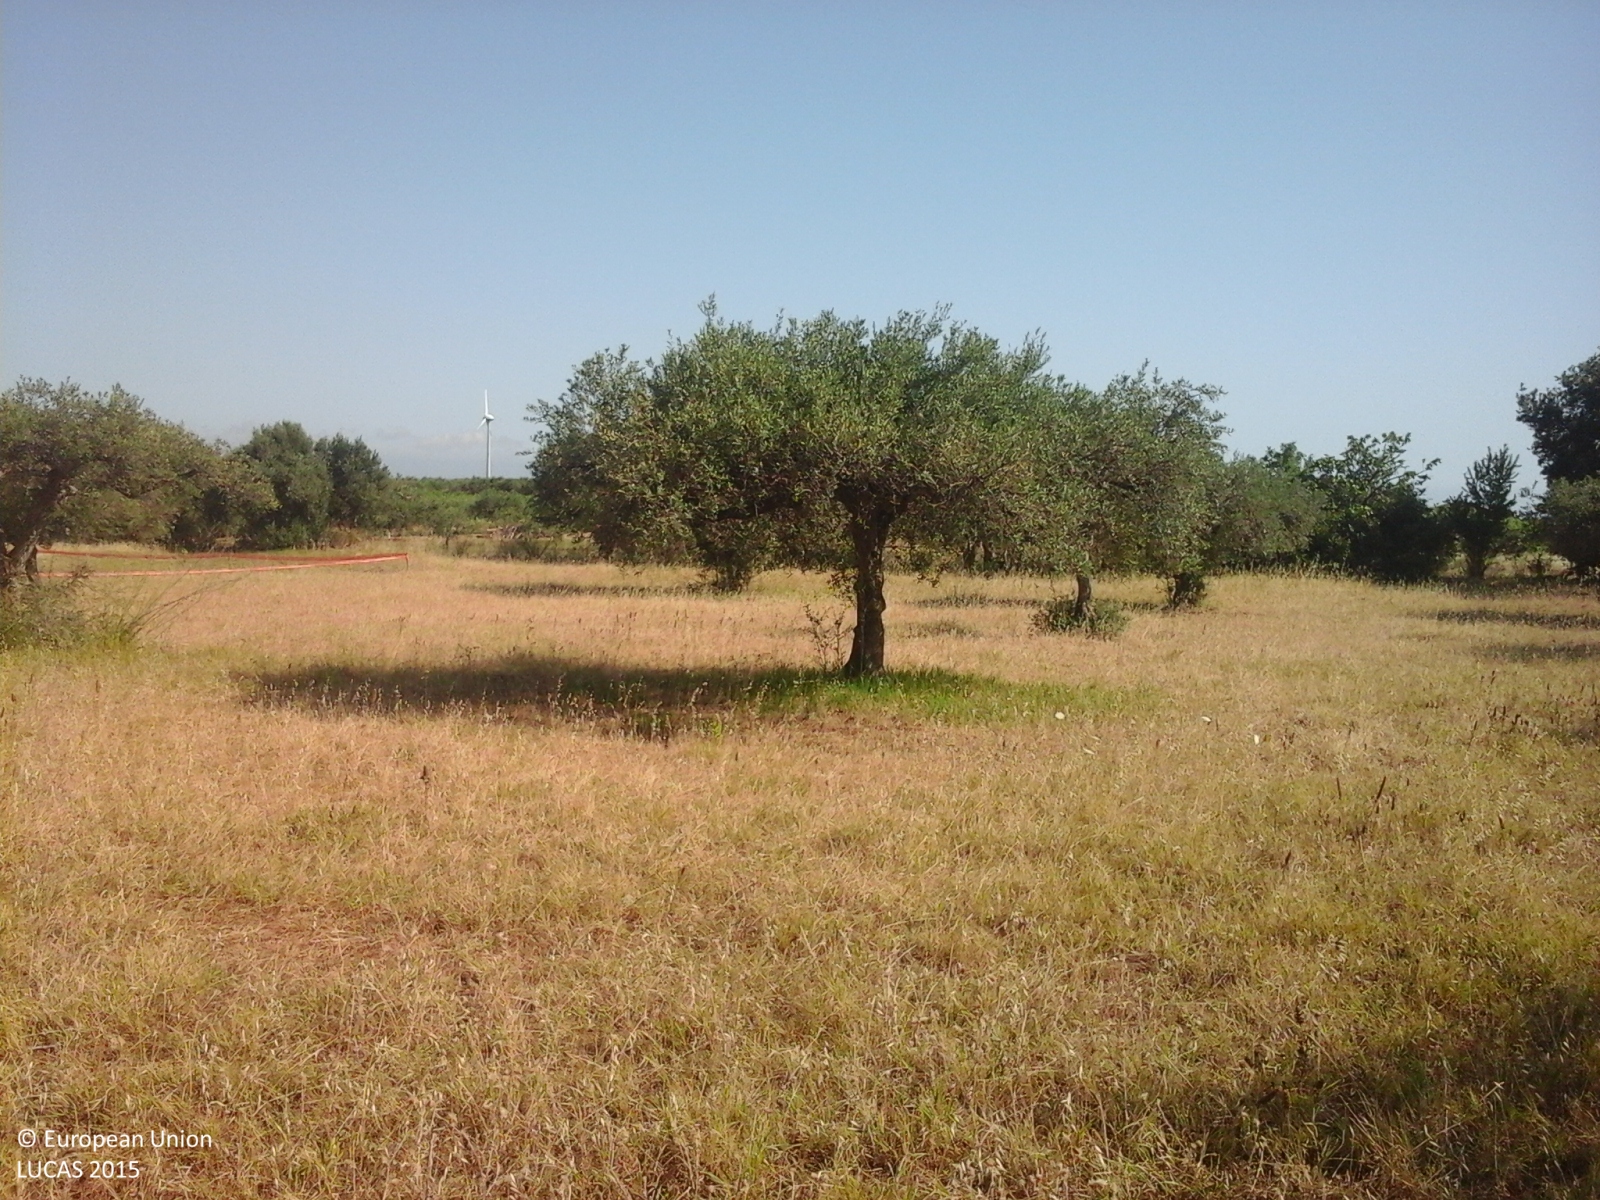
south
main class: Cropland
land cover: Olive groves
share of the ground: 25 - 50 %
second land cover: Spontaneously vegetated surfaces
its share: > 75 %
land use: Agriculture (excluding fallow land and kitchen gardens)
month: May
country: IT
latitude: 37.6282
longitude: 12.9801
